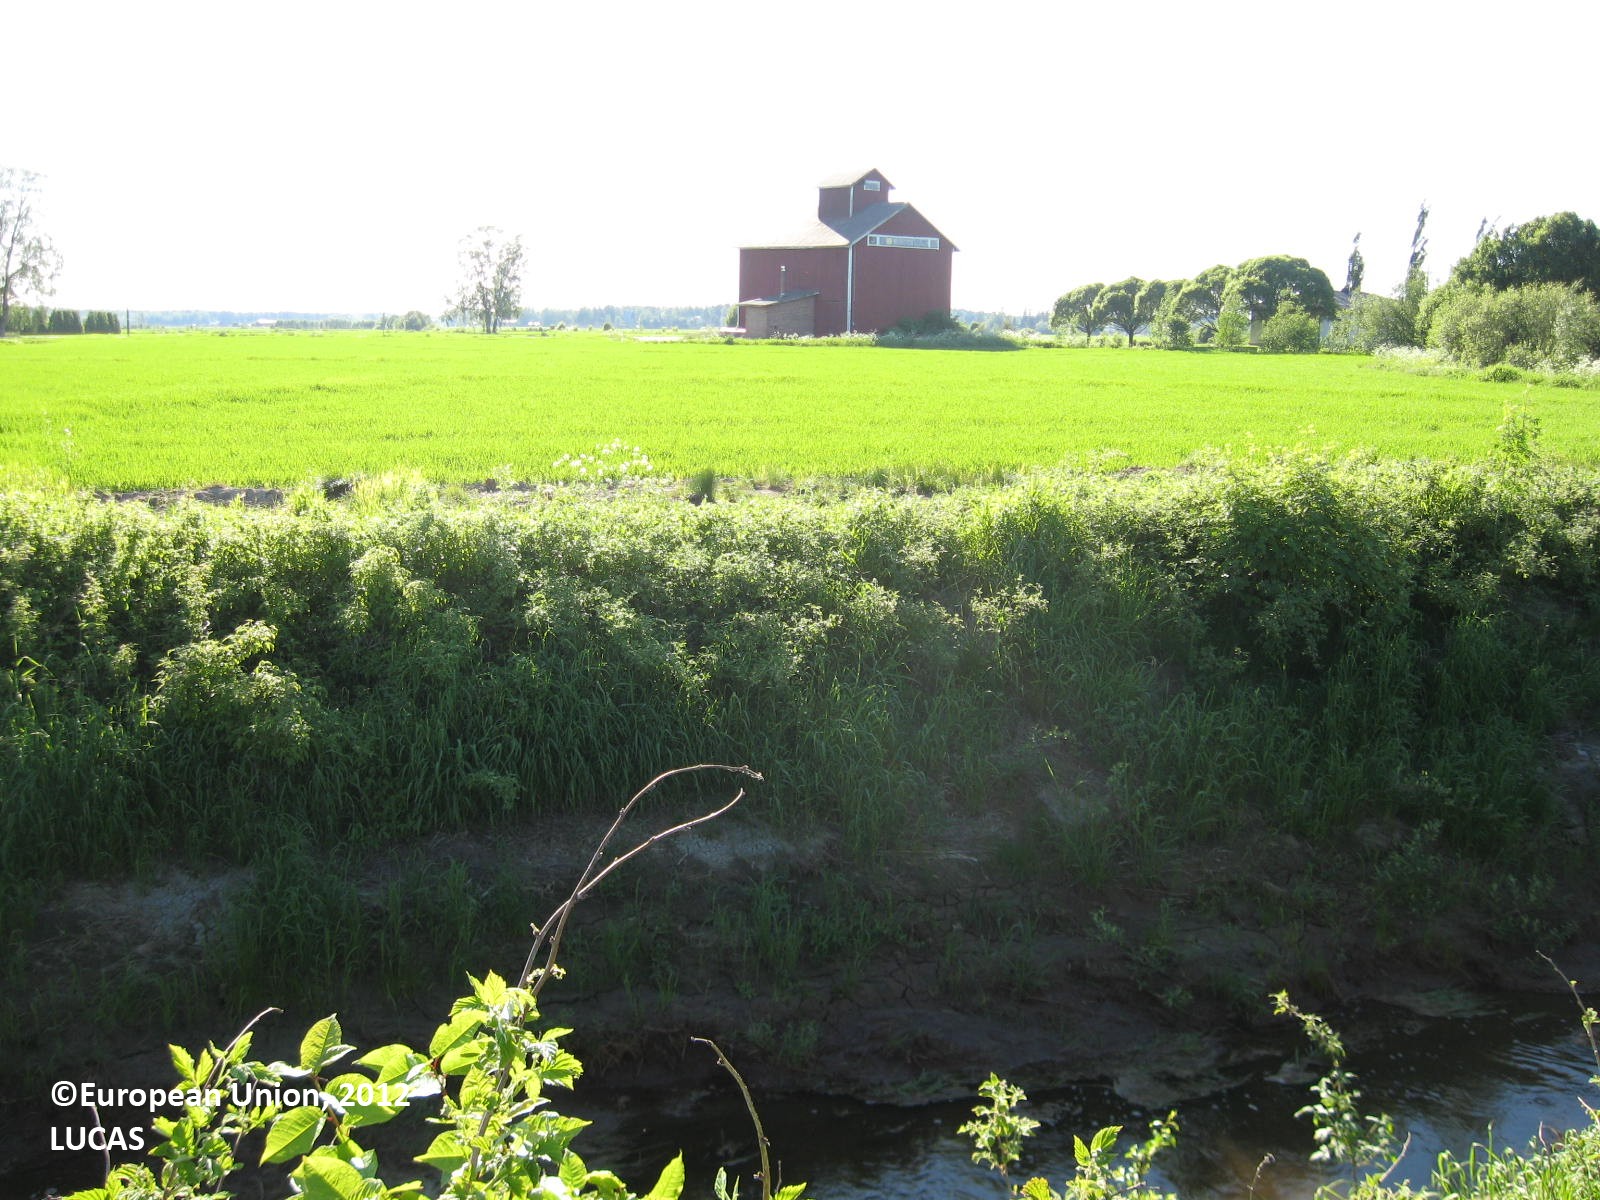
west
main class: Cropland
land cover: Oats
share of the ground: > 75 %
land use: Agriculture (excluding fallow land and kitchen gardens)
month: June
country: FI
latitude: 62.9970
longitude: 21.9088
